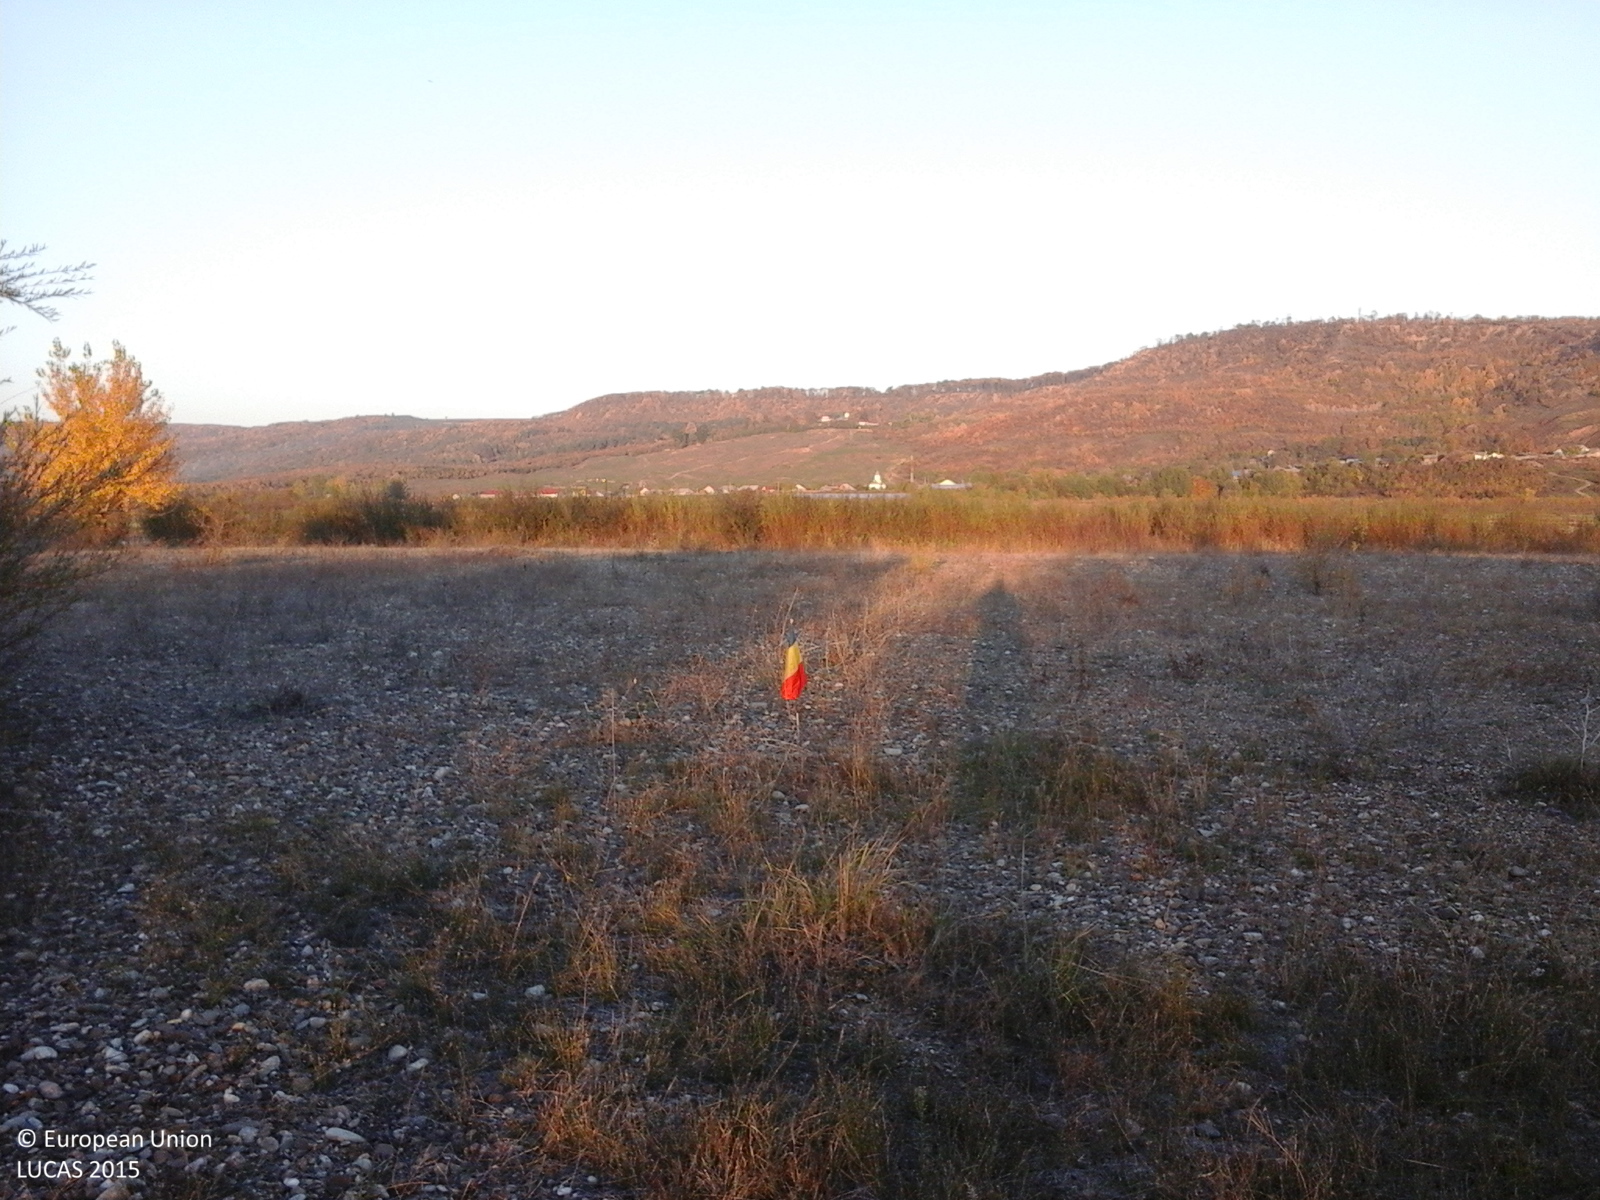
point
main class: Grassland
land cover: Spontaneously vegetated surfaces
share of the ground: 25 - 50 %
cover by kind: consolidated bare surface 75 %, herbaceous plants 25 %
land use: Semi-natural and natural areas not in use
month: October
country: RO
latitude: 46.0407
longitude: 27.2468
